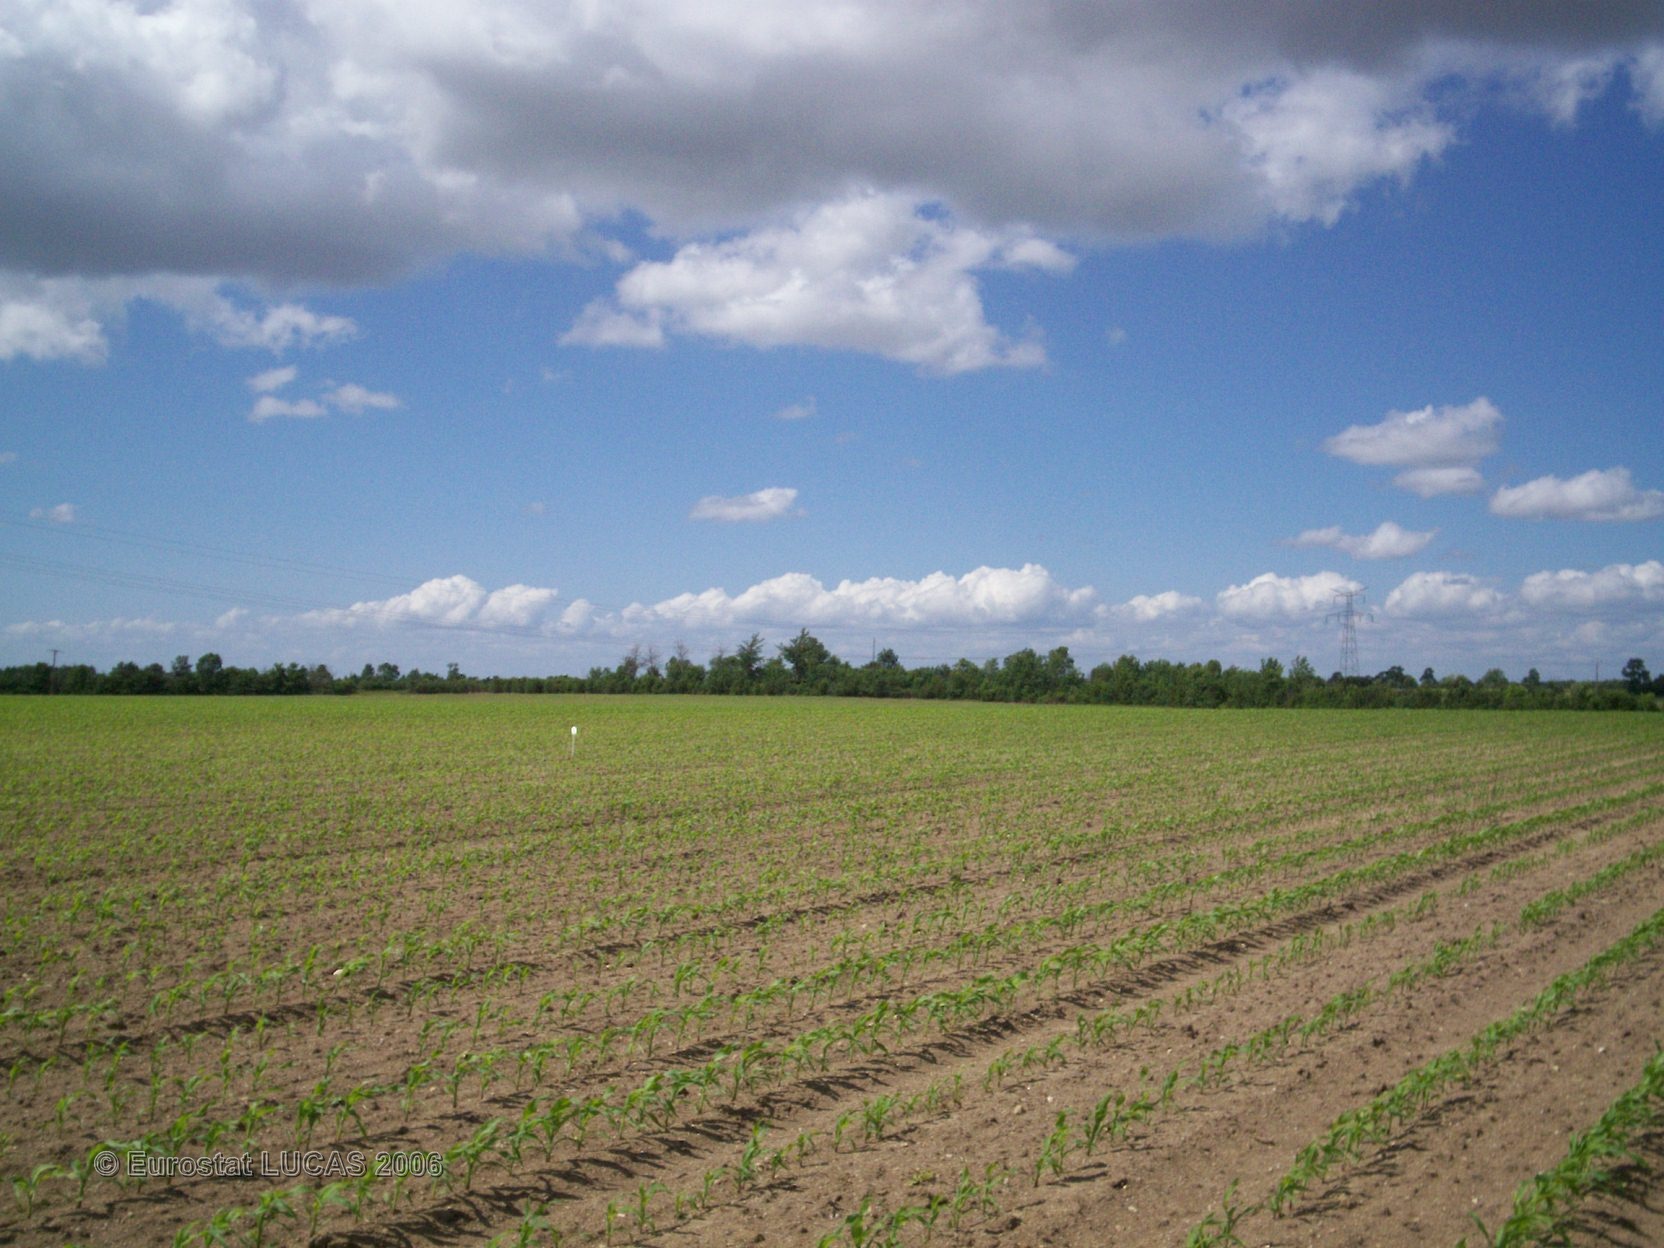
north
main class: Cropland
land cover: Maize
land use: Agriculture (excluding fallow land and kitchen gardens)
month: May
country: FR
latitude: 46.0324
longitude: -0.6851
